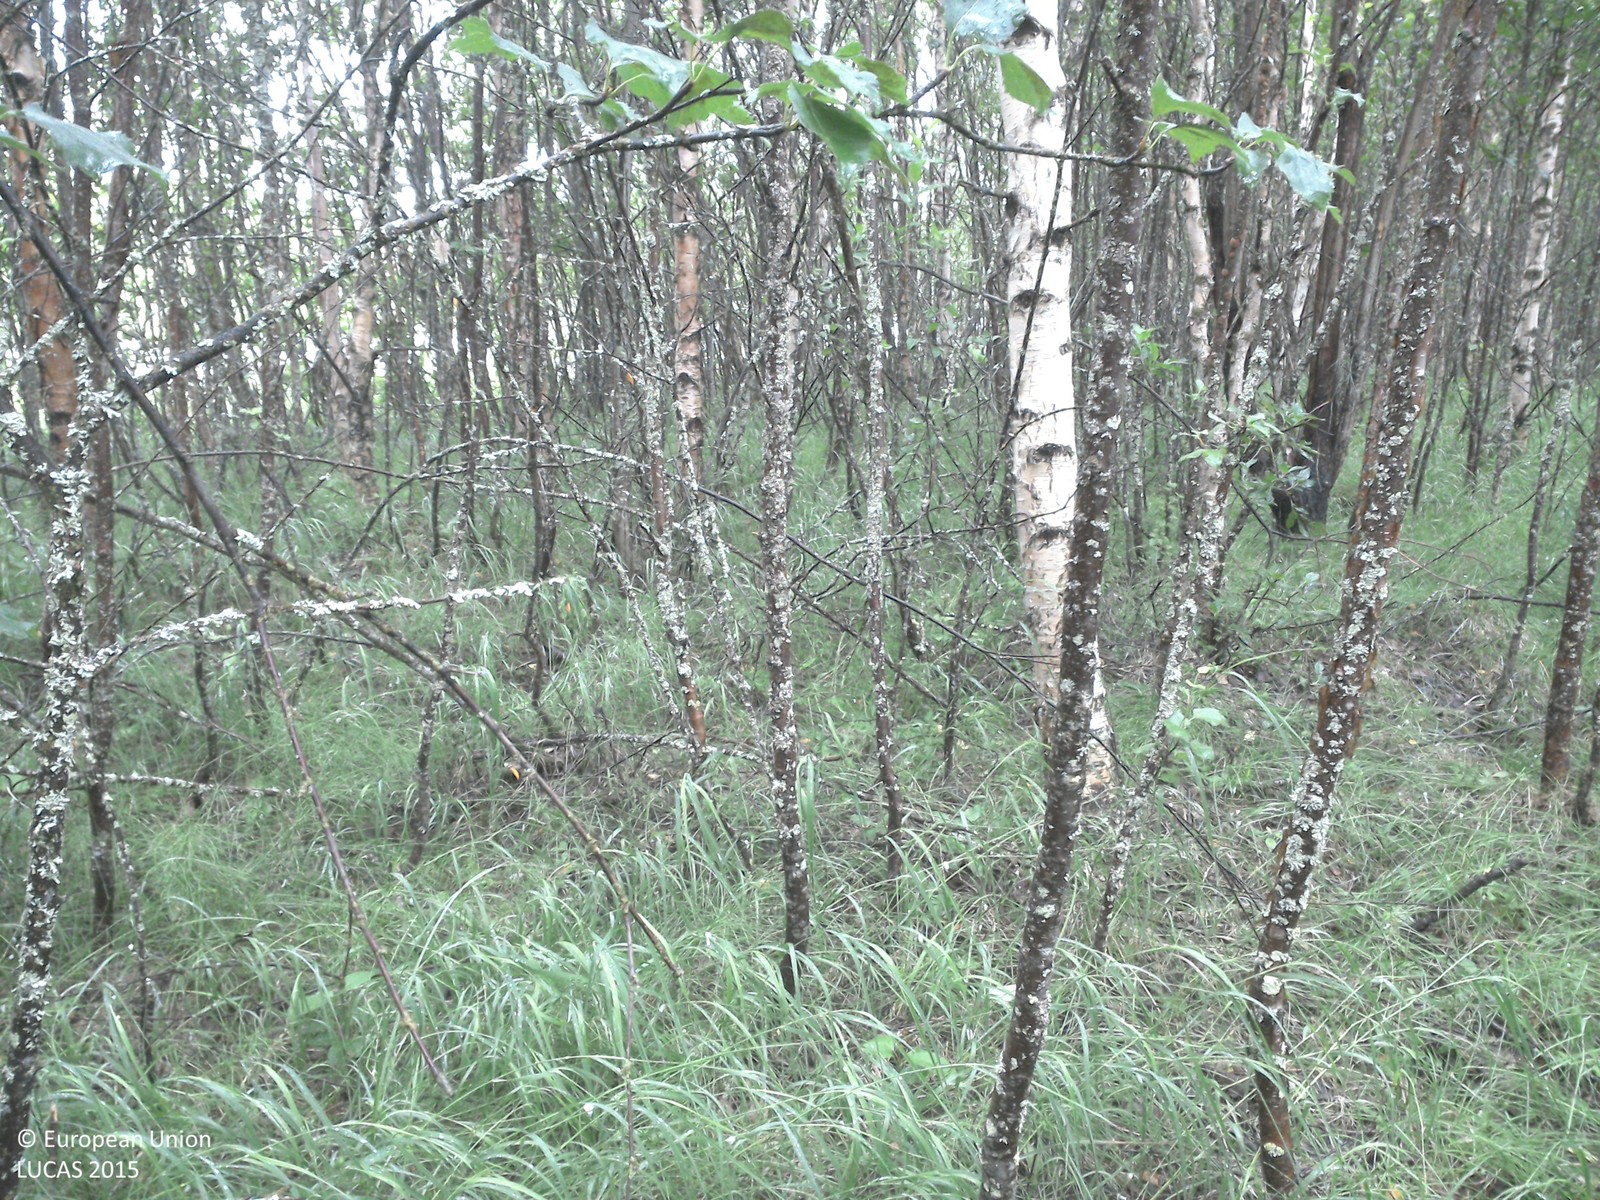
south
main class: Woodland
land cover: Broadleaved woodland
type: boreal forest
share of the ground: 50 - 75 %
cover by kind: broadleaved forest trees 60 %, herbaceous plants 40 %
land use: Forestry
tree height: > 5 m
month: July
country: SE
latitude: 67.6720
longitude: 21.6238
